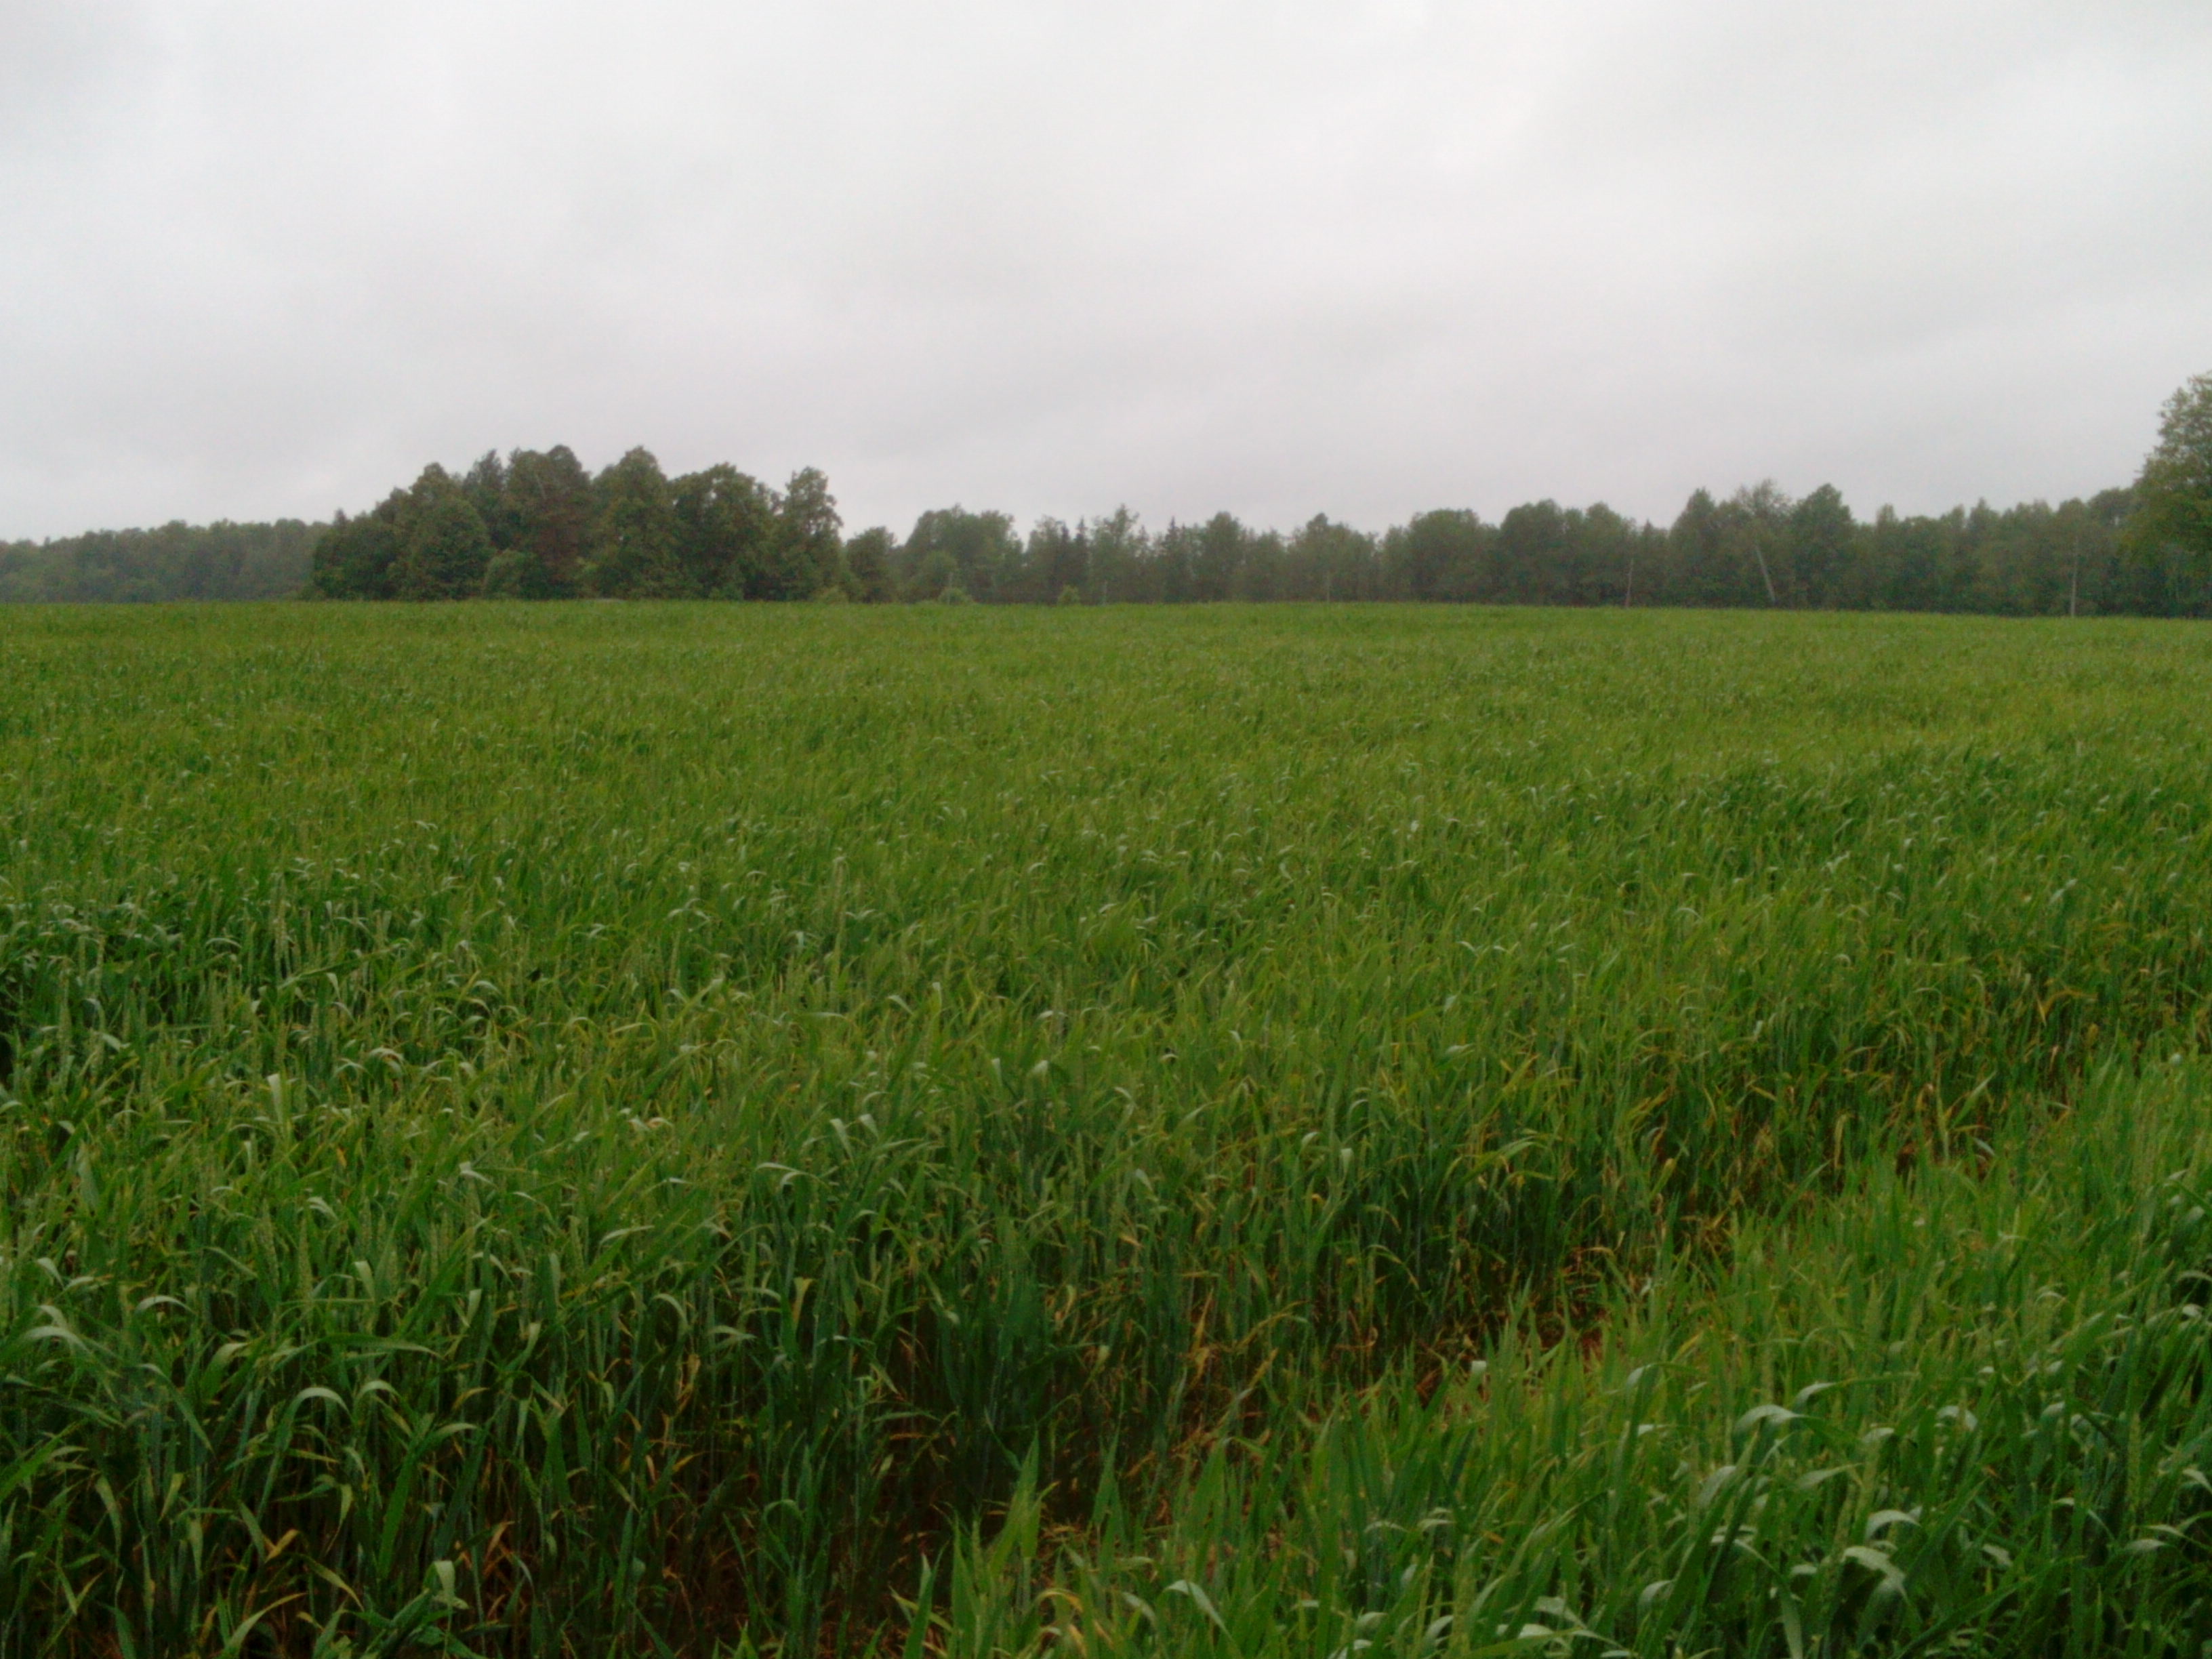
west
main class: Cropland
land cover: Common wheat
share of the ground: > 75 %
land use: Agriculture (excluding fallow land and kitchen gardens)
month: June
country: LV
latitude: 56.8066
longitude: 21.9873
